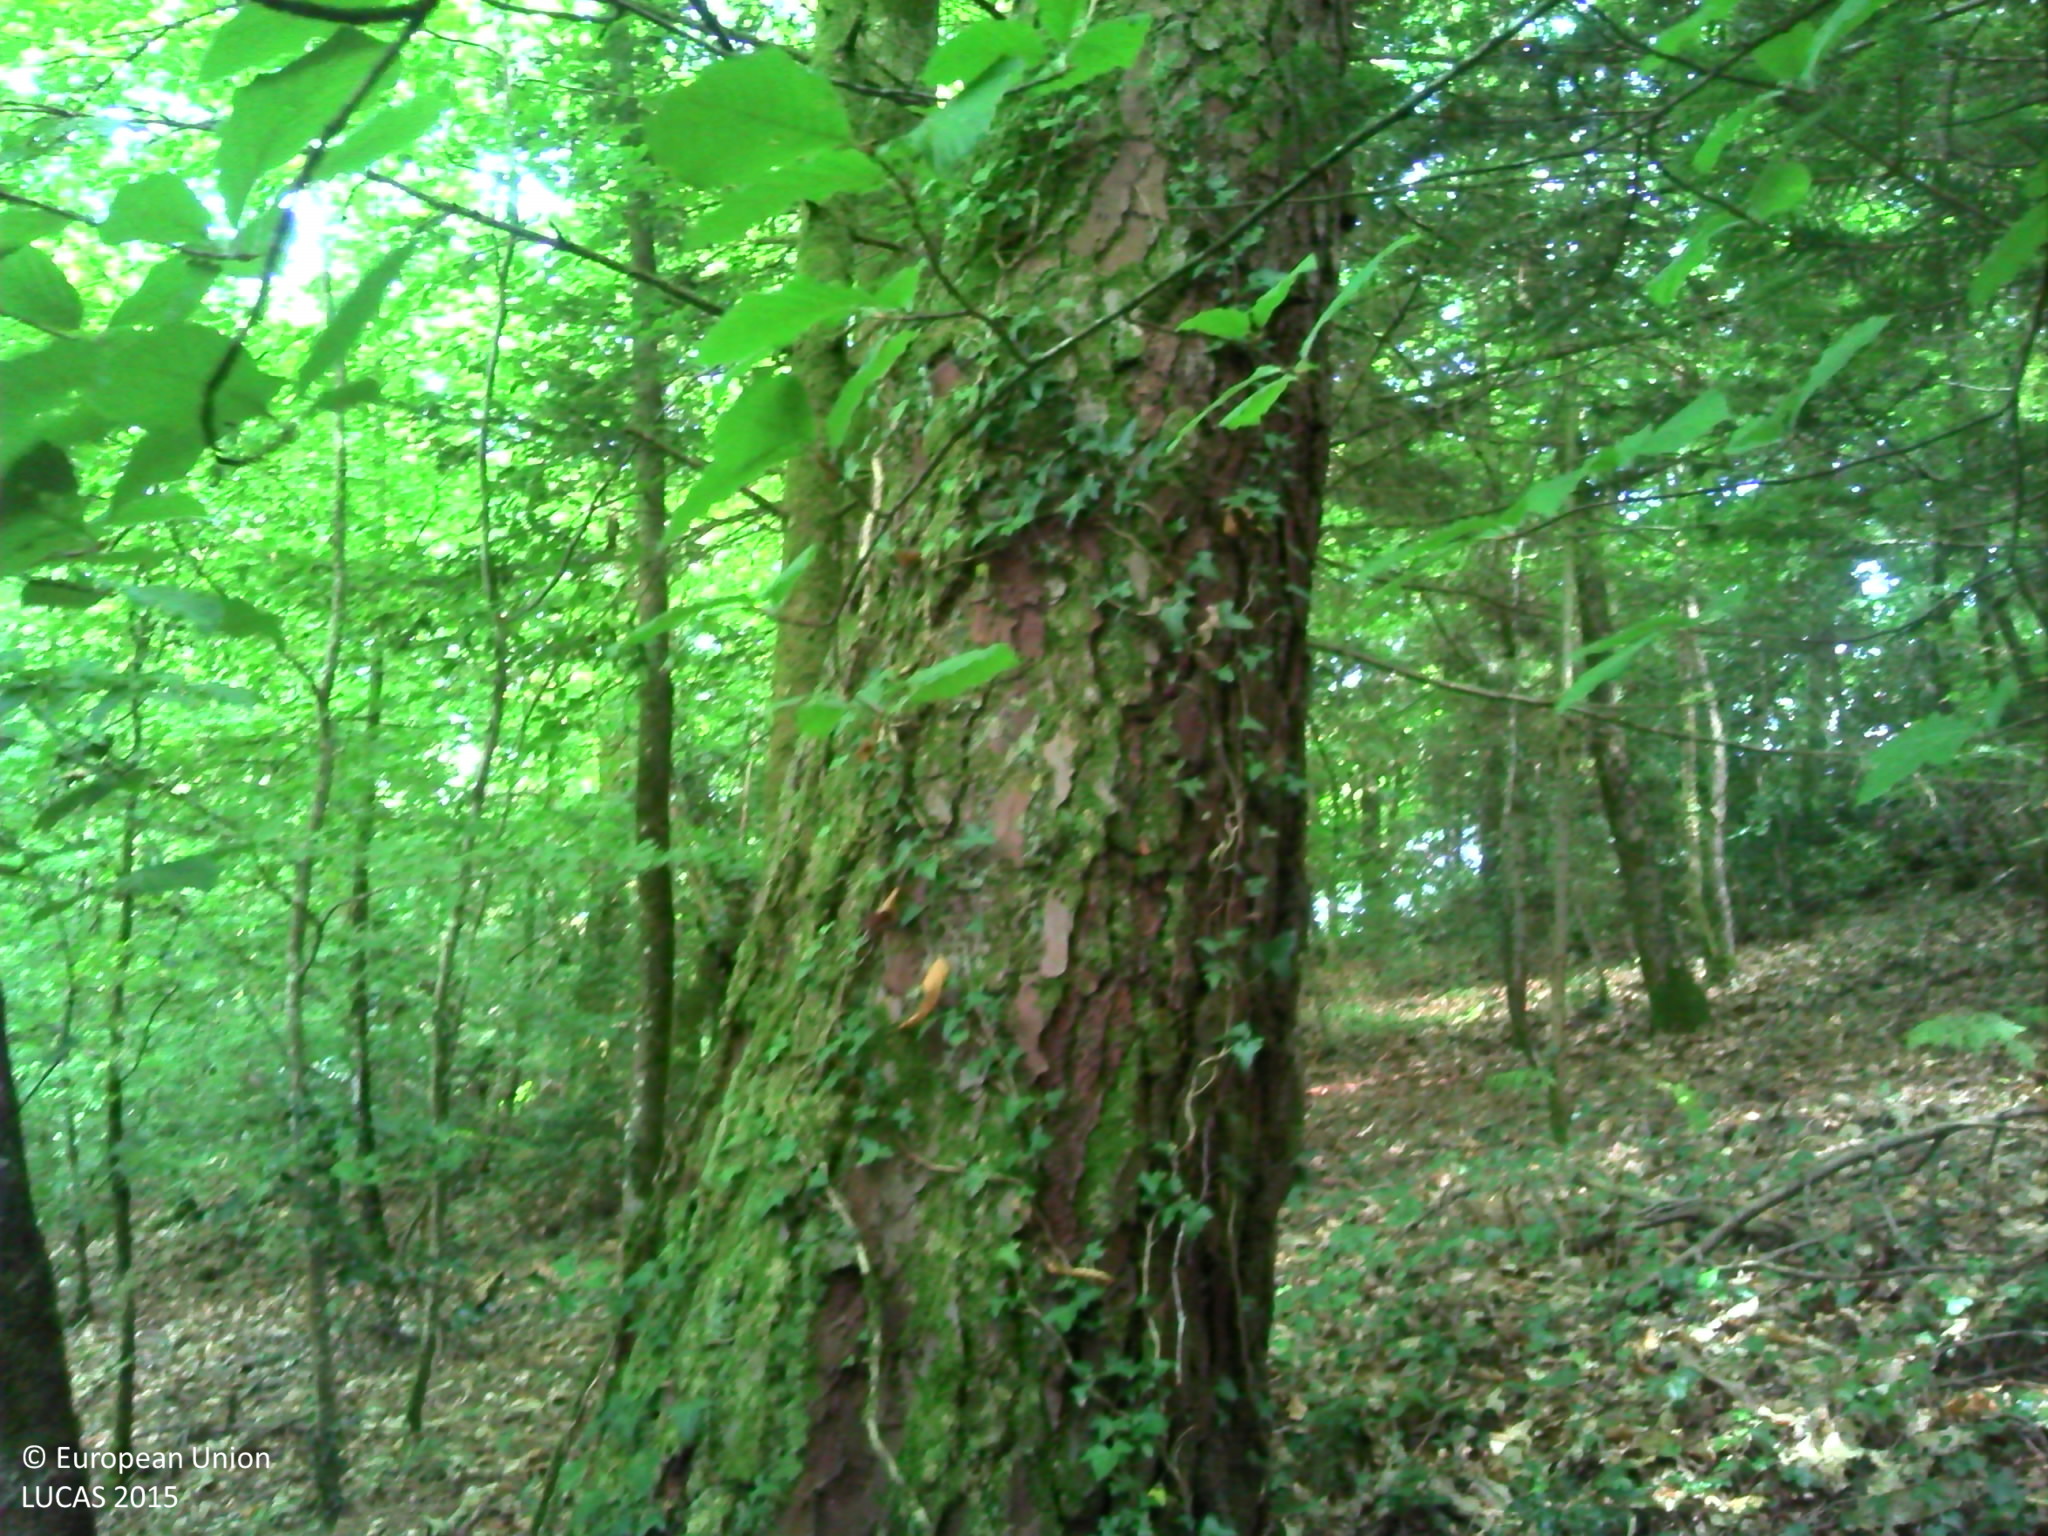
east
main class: Woodland
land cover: Broadleaved woodland
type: acidophilous oak and oak-birch forest
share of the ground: > 75 %
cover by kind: broadleaved forest trees 60 %, coniferous forest trees 10 %, shrubs 10 %, herbaceous plants 10 %, consolidated bare surface 10 %
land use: Forestry
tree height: > 5 m
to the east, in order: Broadleaved woodland; Tracks; Dry stone walls; Pine dominated mixed woodland; Dry stone walls; Spontaneously vegetated surfaces; Grassland without tree/shrub cover; Artificial constructions in urban areas; Broadleaved woodland; Dry stone walls; Tracks; Dry stone walls; Broadleaved woodland; Spontaneously vegetated surfaces; Artificial constructions in urban areas
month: July
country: FR
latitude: 47.9068
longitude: -3.1405
